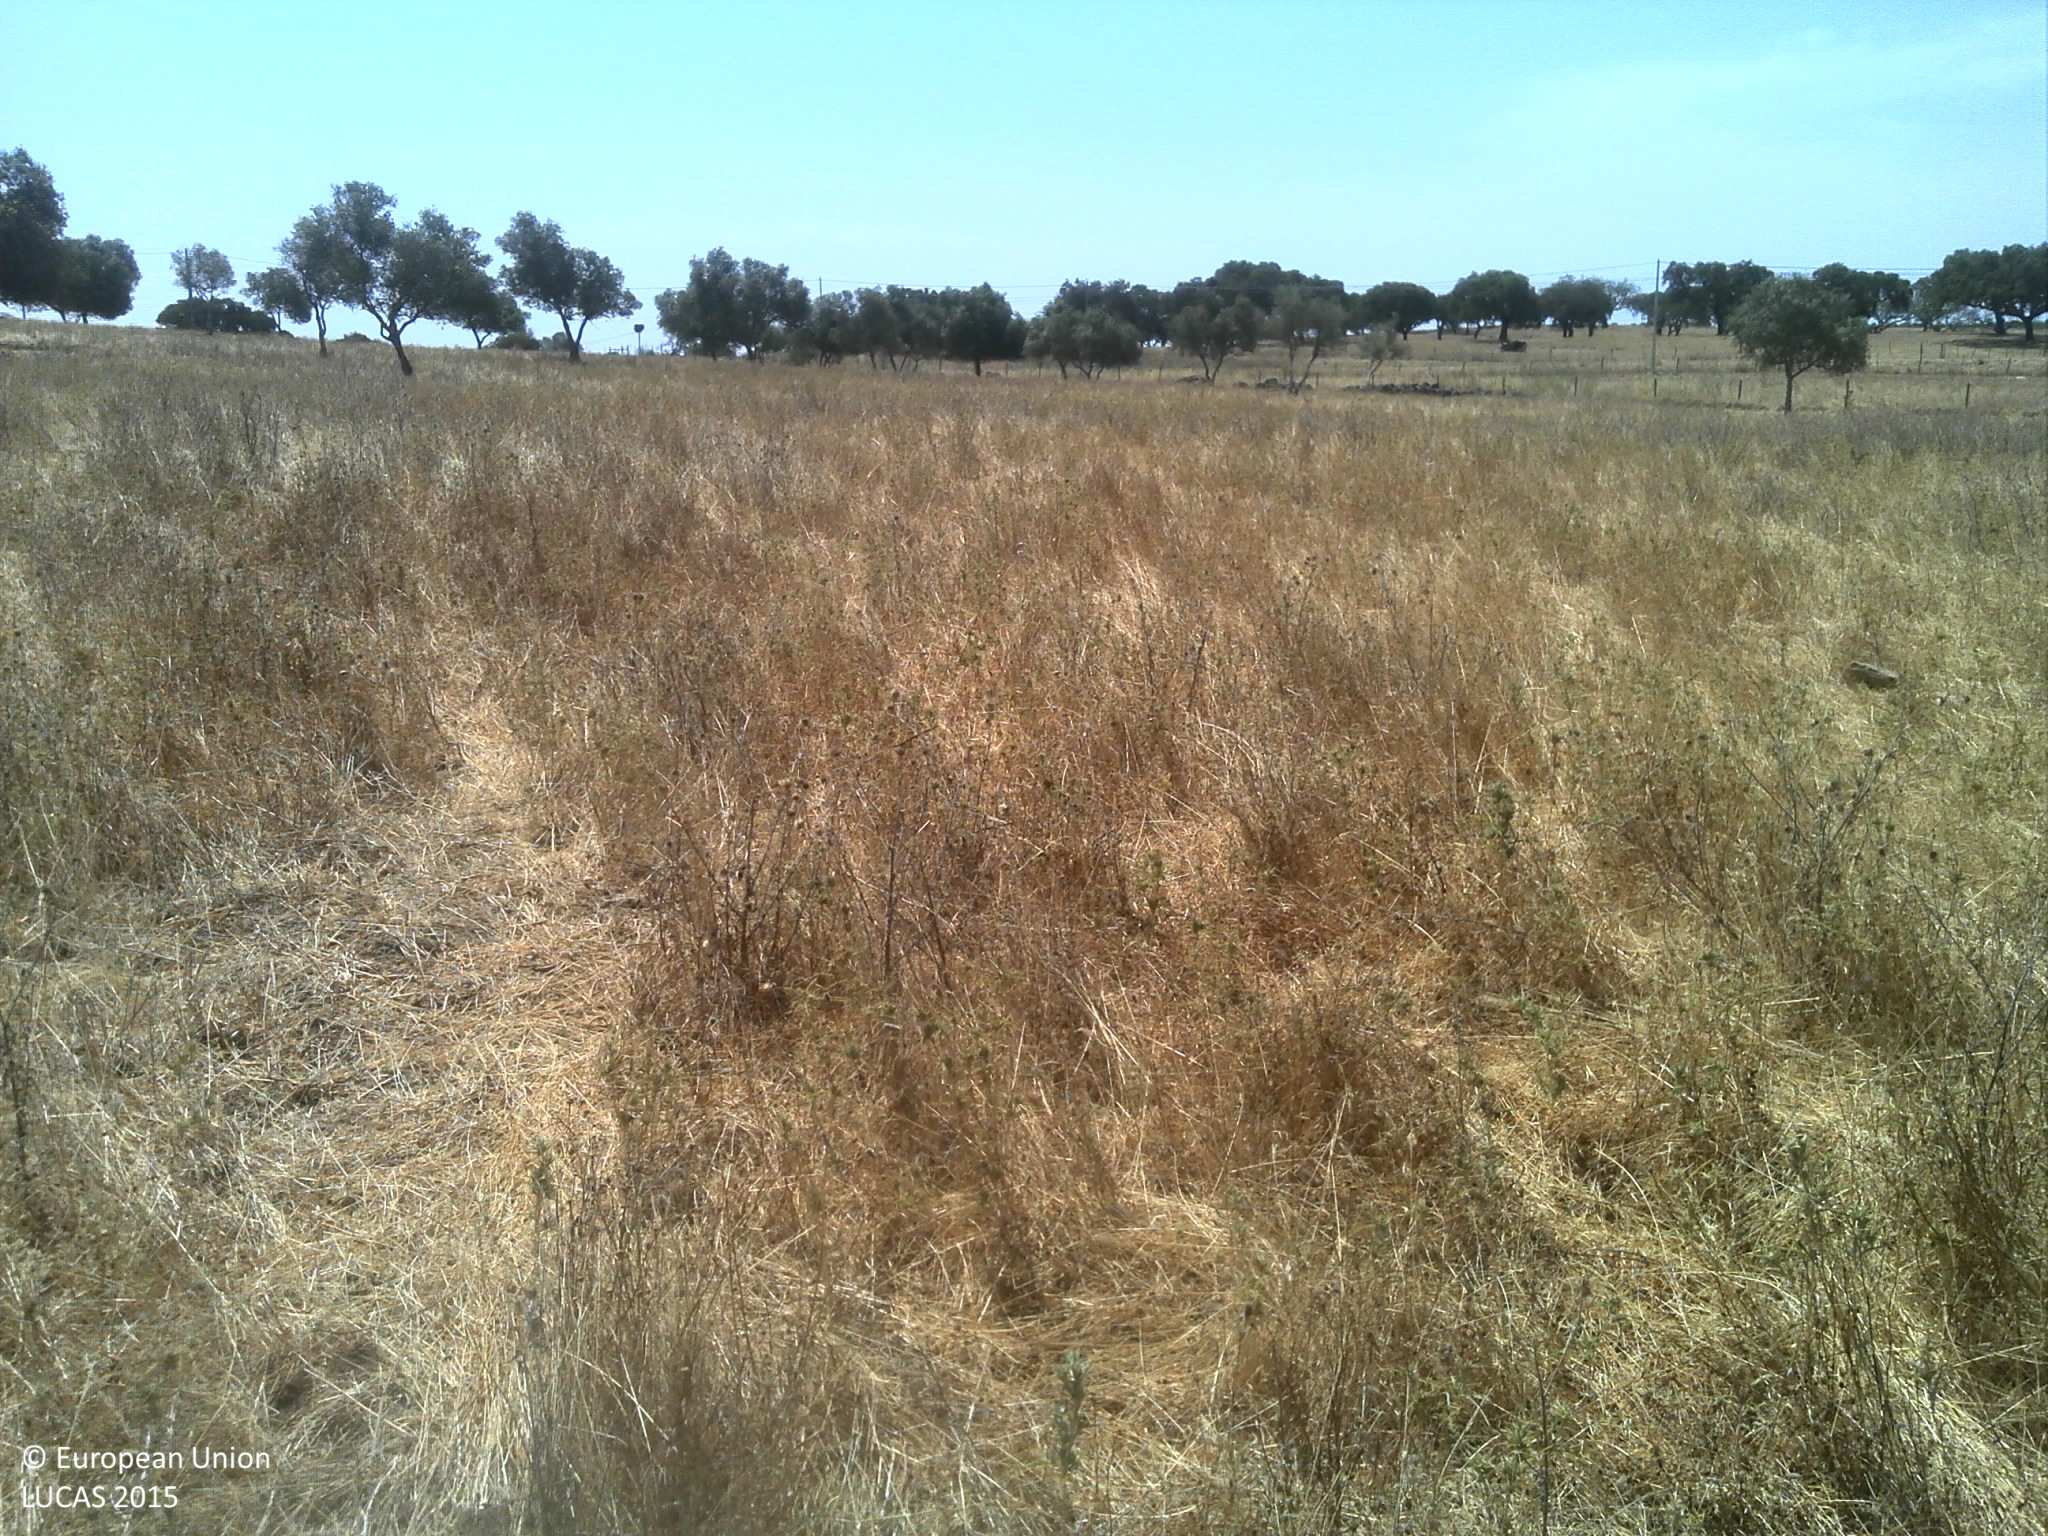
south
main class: Grassland
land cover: Grassland without tree/shrub cover
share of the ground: 25 - 50 %
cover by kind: herbaceous plants 60 %, consolidated bare surface 40 %
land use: Agriculture (excluding fallow land and kitchen gardens)
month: July
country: PT
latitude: 37.6829
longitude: -8.2756
